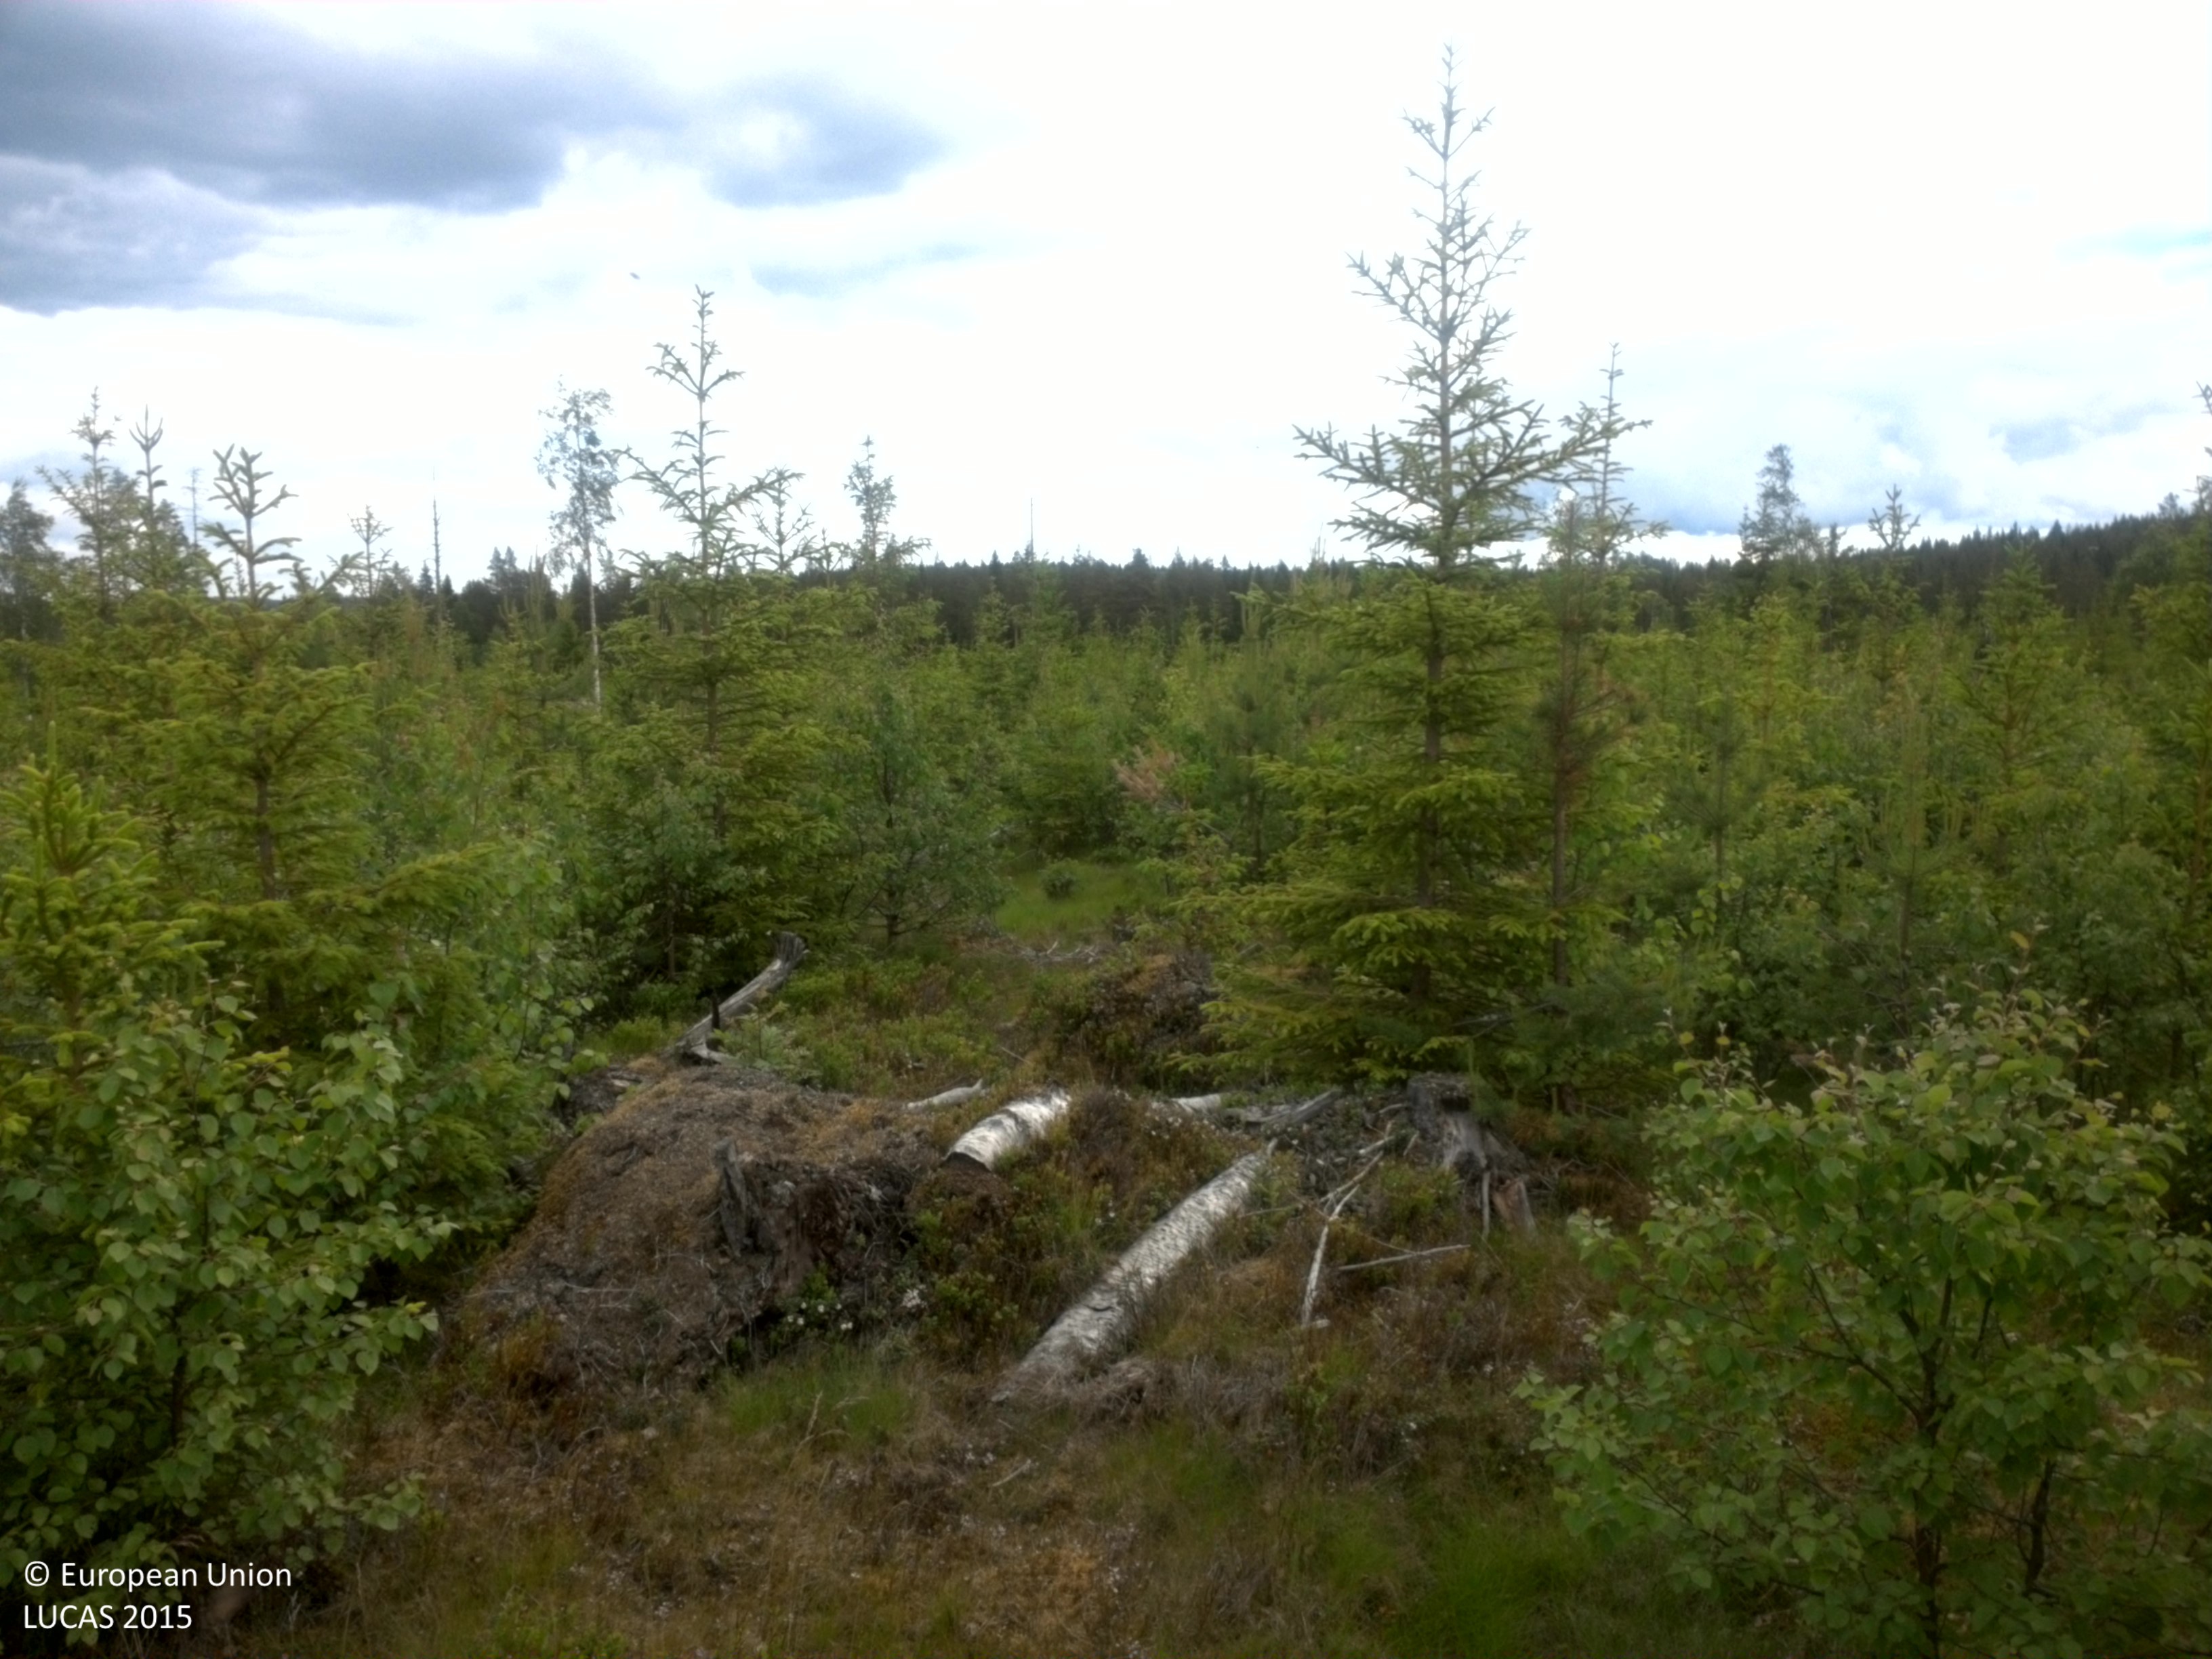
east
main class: Woodland
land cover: Other mixed woodland
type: boreal forest
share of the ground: > 75 %
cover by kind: coniferous forest trees 40 %, broadleaved forest trees 40 %, shrubs 10 %, herbaceous plants 10 %
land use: Forestry
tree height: < 5 m
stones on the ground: 25 - 50 %
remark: Clear cut
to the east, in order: Other mixed woodland; Ditches and canals; Other mixed woodland; Ditches and canals; Abandoned hedges; Grass margins; Paved roads, cycling and walking lanes; Grass margins; Shrubland without tree cover
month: July
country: SE
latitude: 64.6262
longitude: 20.3277
